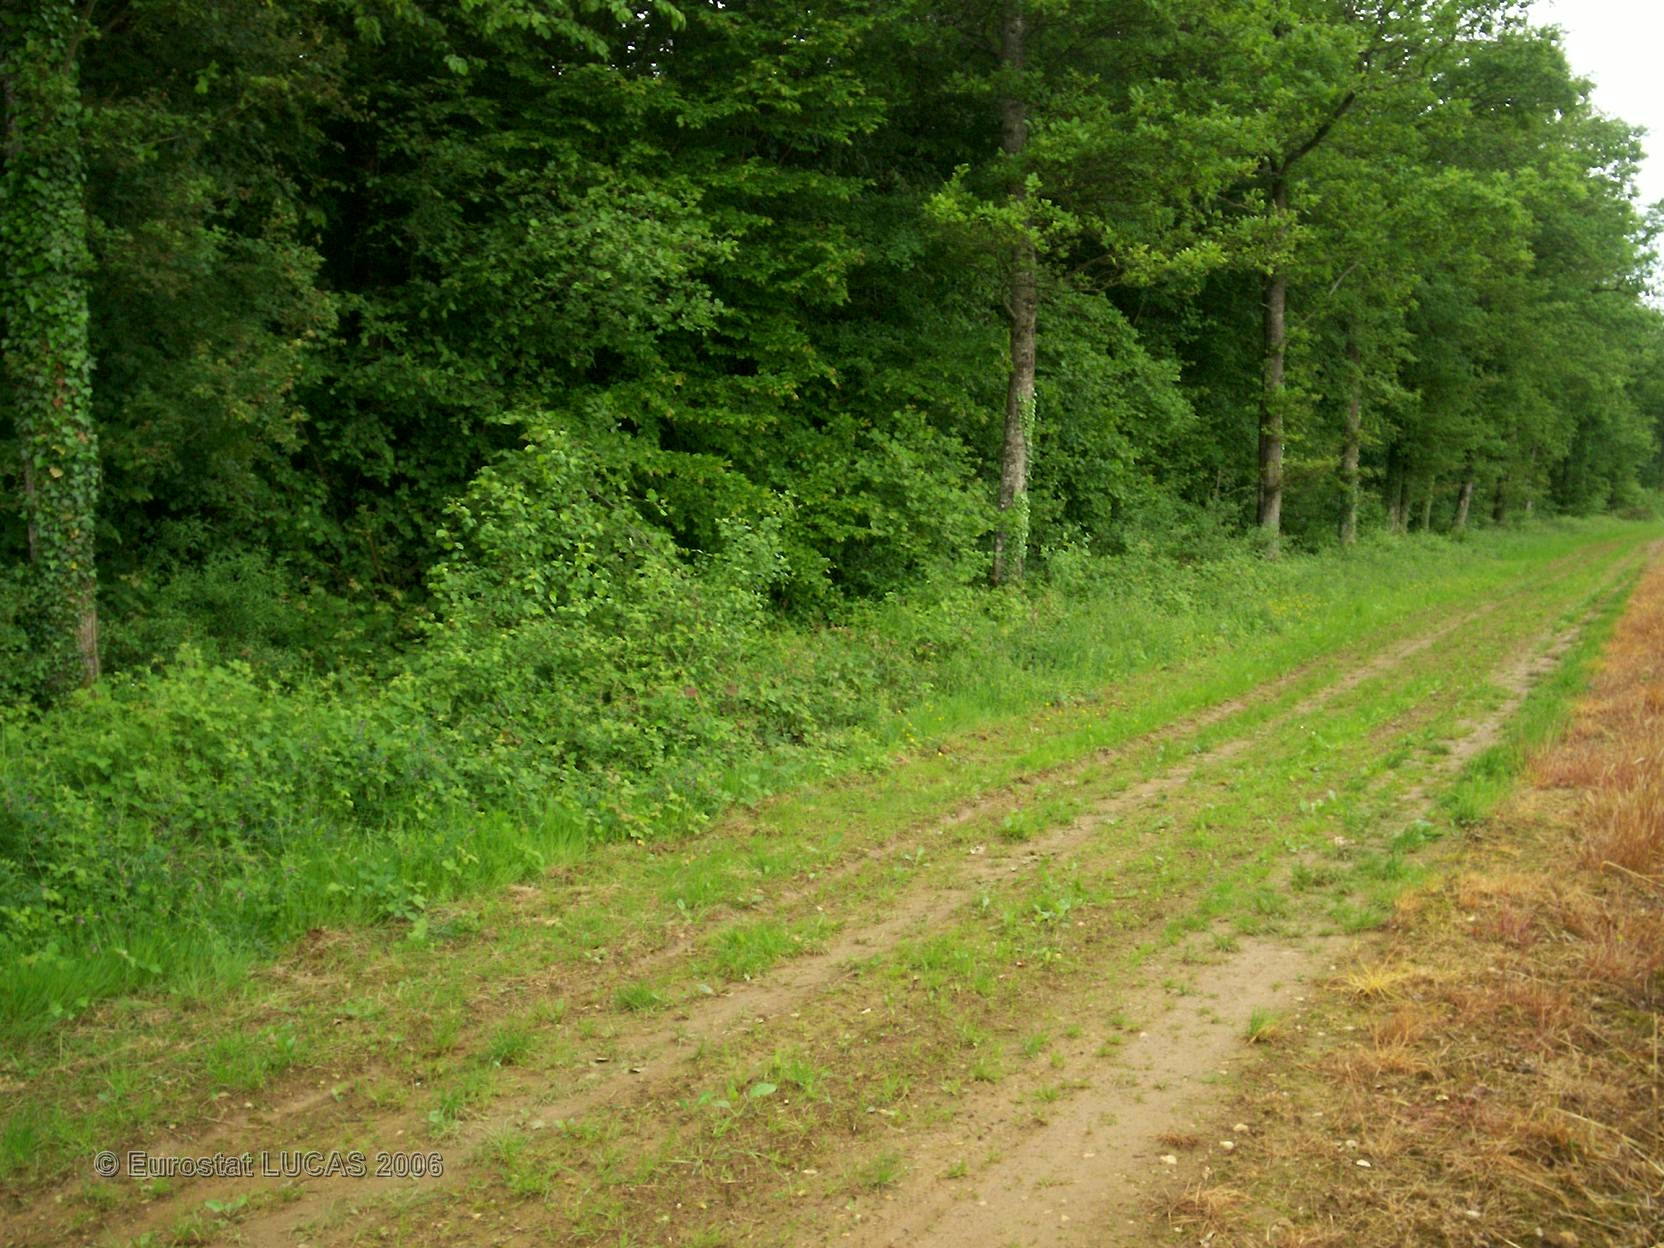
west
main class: Cropland
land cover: Barley
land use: Agriculture (excluding fallow land and kitchen gardens)
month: May
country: FR
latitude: 48.2494
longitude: 4.5164
